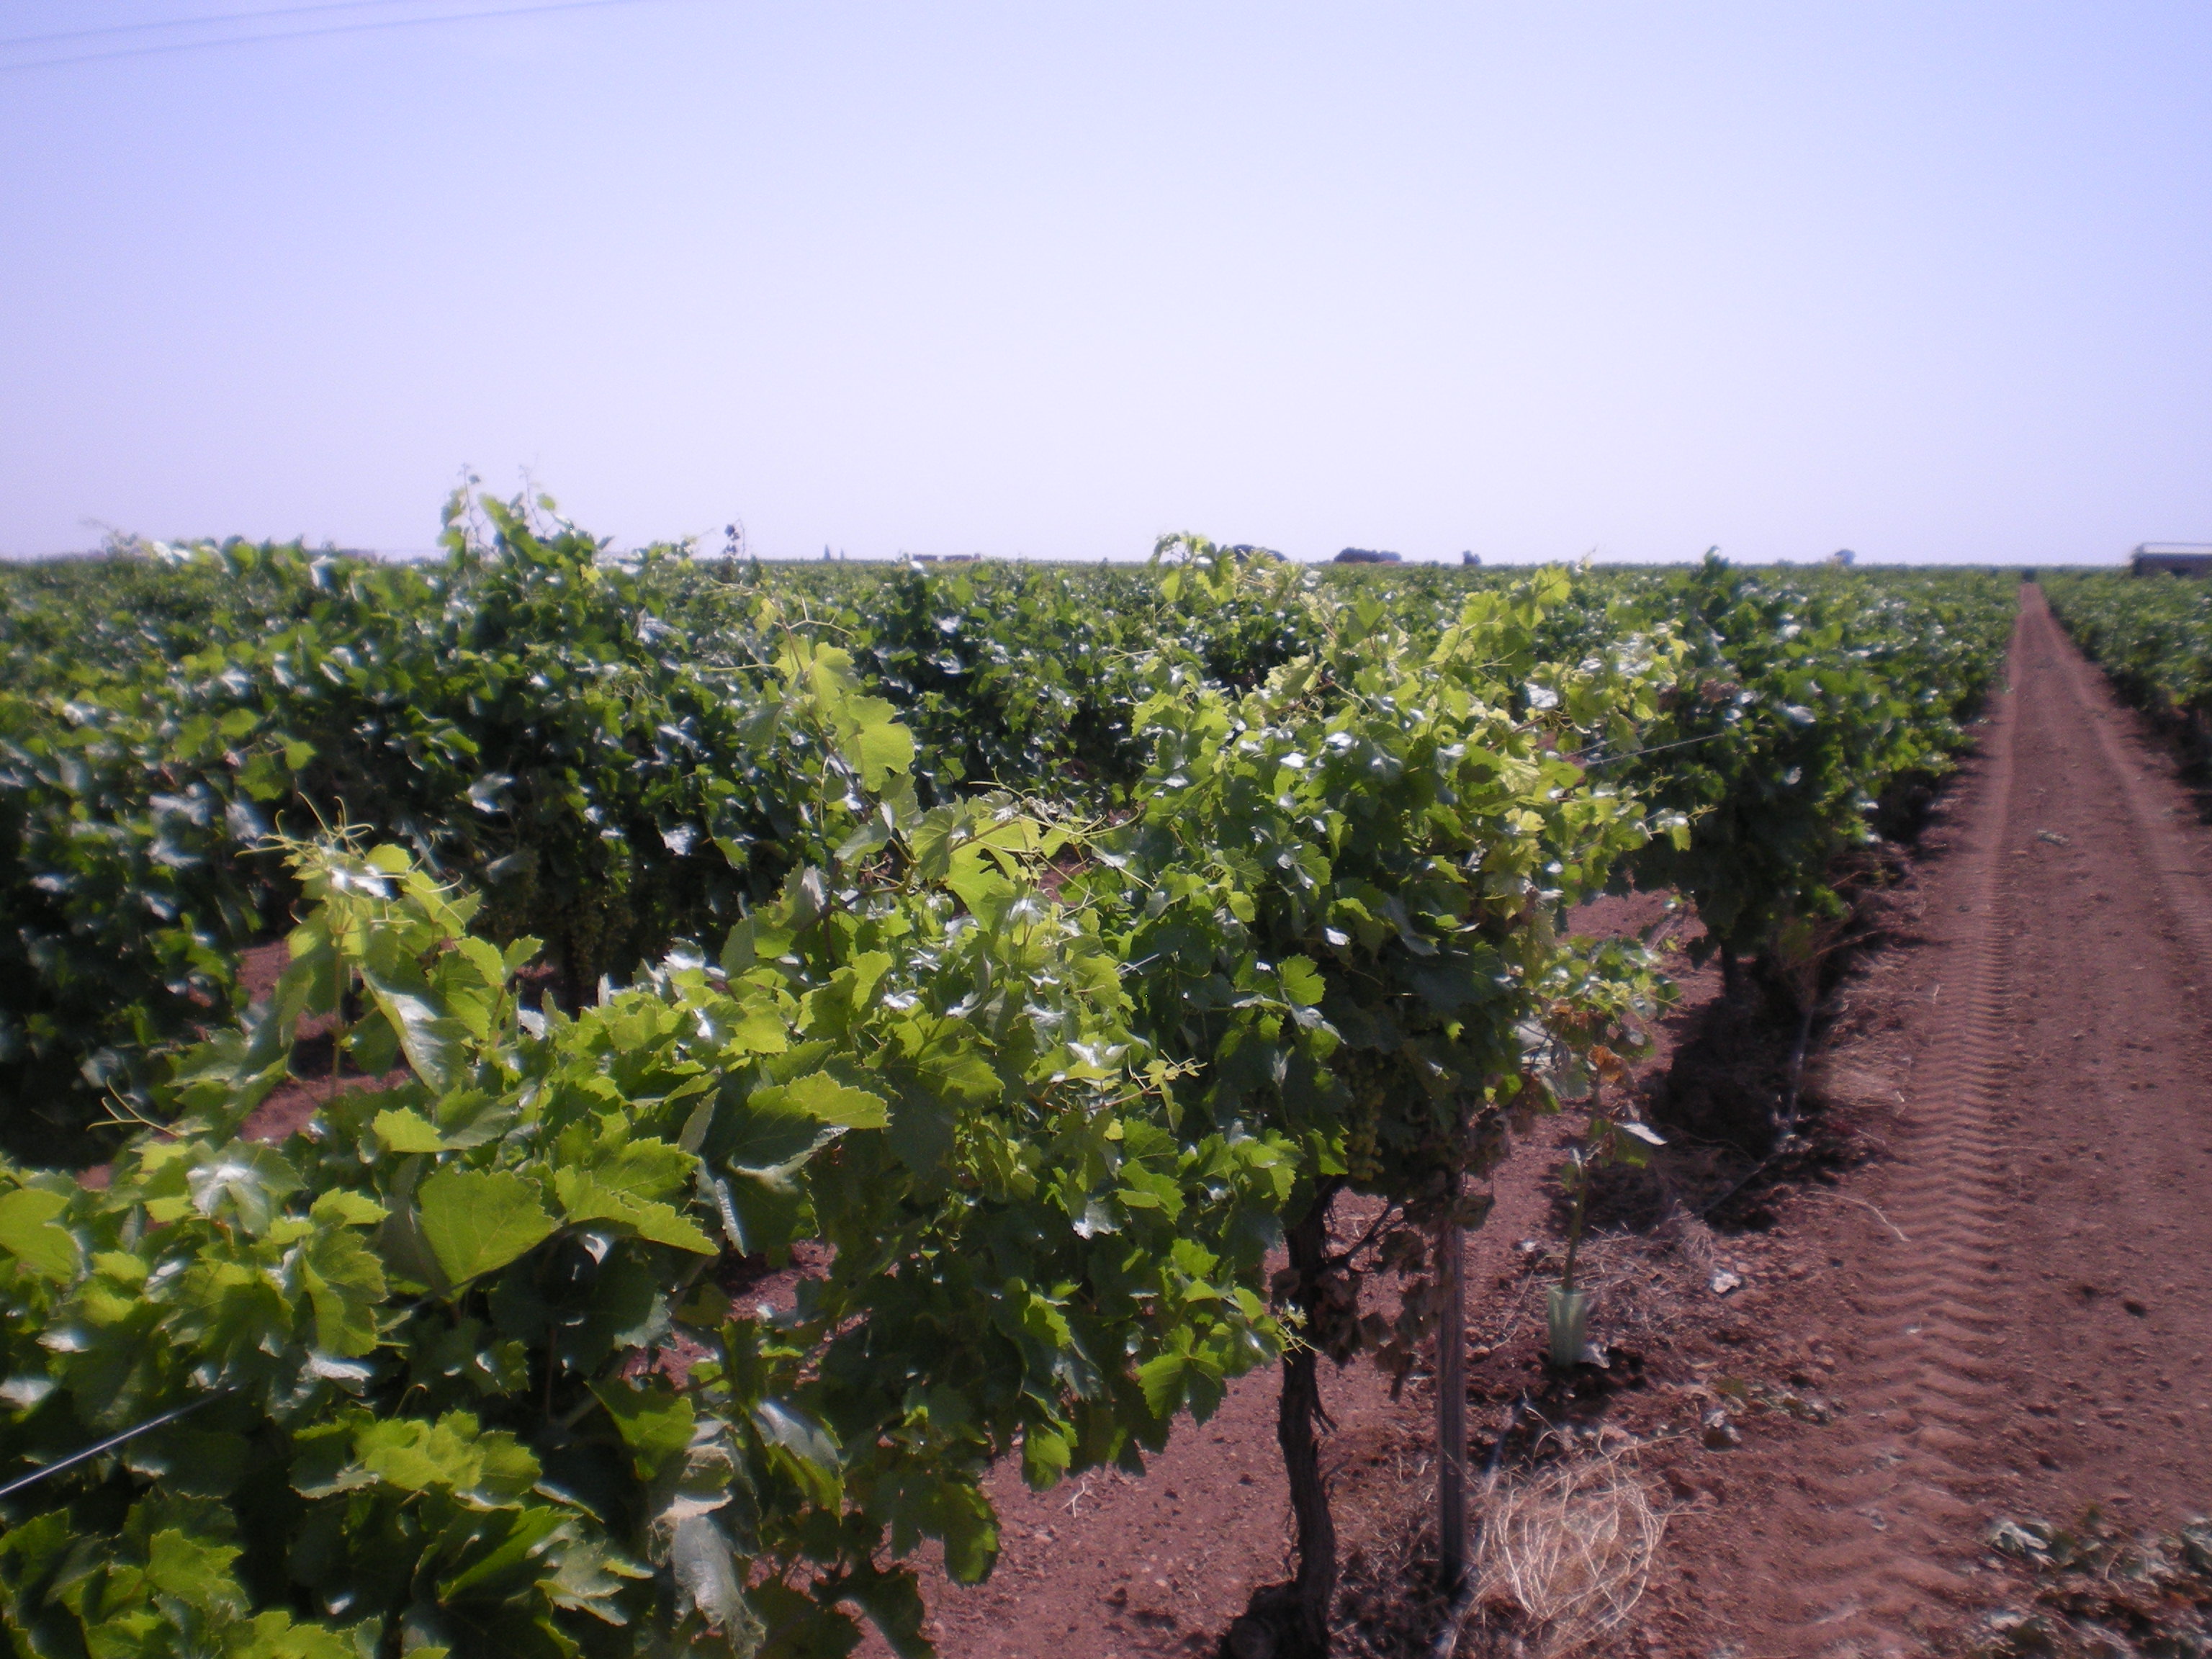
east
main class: Cropland
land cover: Vineyards
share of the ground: 10 - 25 %
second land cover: Other bare soil
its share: > 75 %
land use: Agriculture (excluding fallow land and kitchen gardens)
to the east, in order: Vineyards; Other bare soil; Electric lines; Vineyards
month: July
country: ES
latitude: 39.2140
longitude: -3.2772
